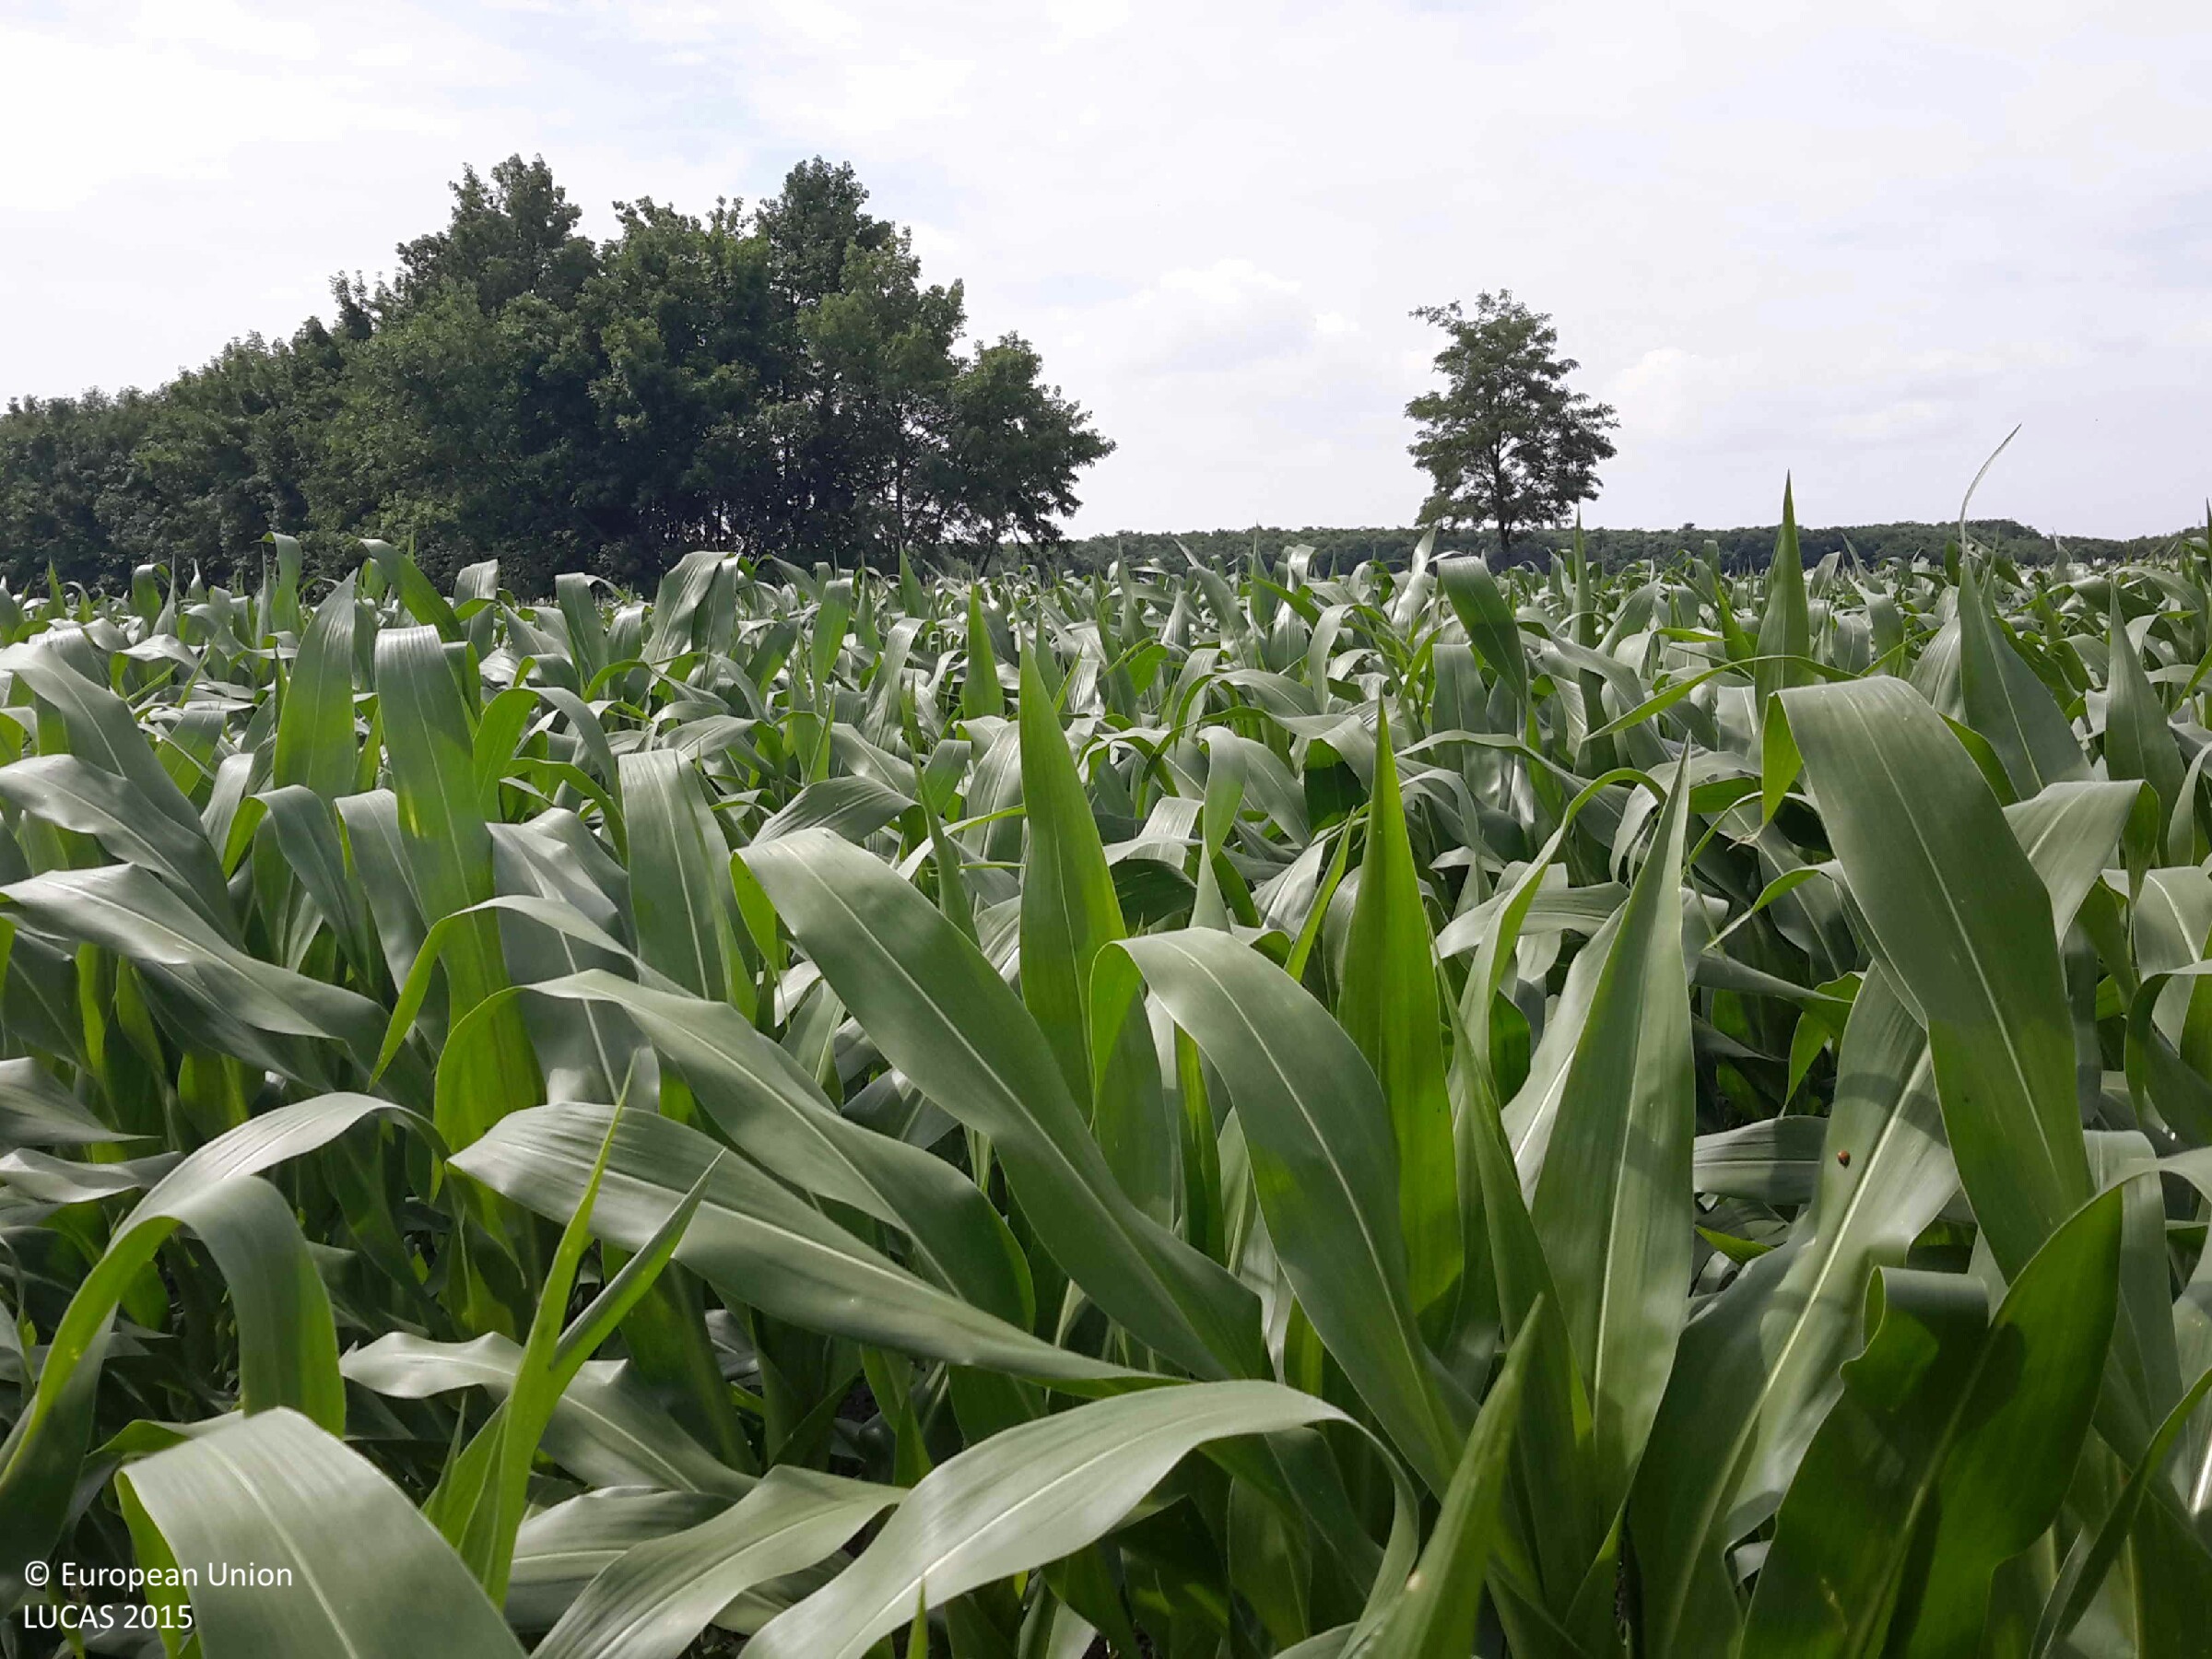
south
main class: Cropland
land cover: Maize
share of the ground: > 75 %
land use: Agriculture (excluding fallow land and kitchen gardens)
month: June
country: HU
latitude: 47.3345
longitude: 17.5112
